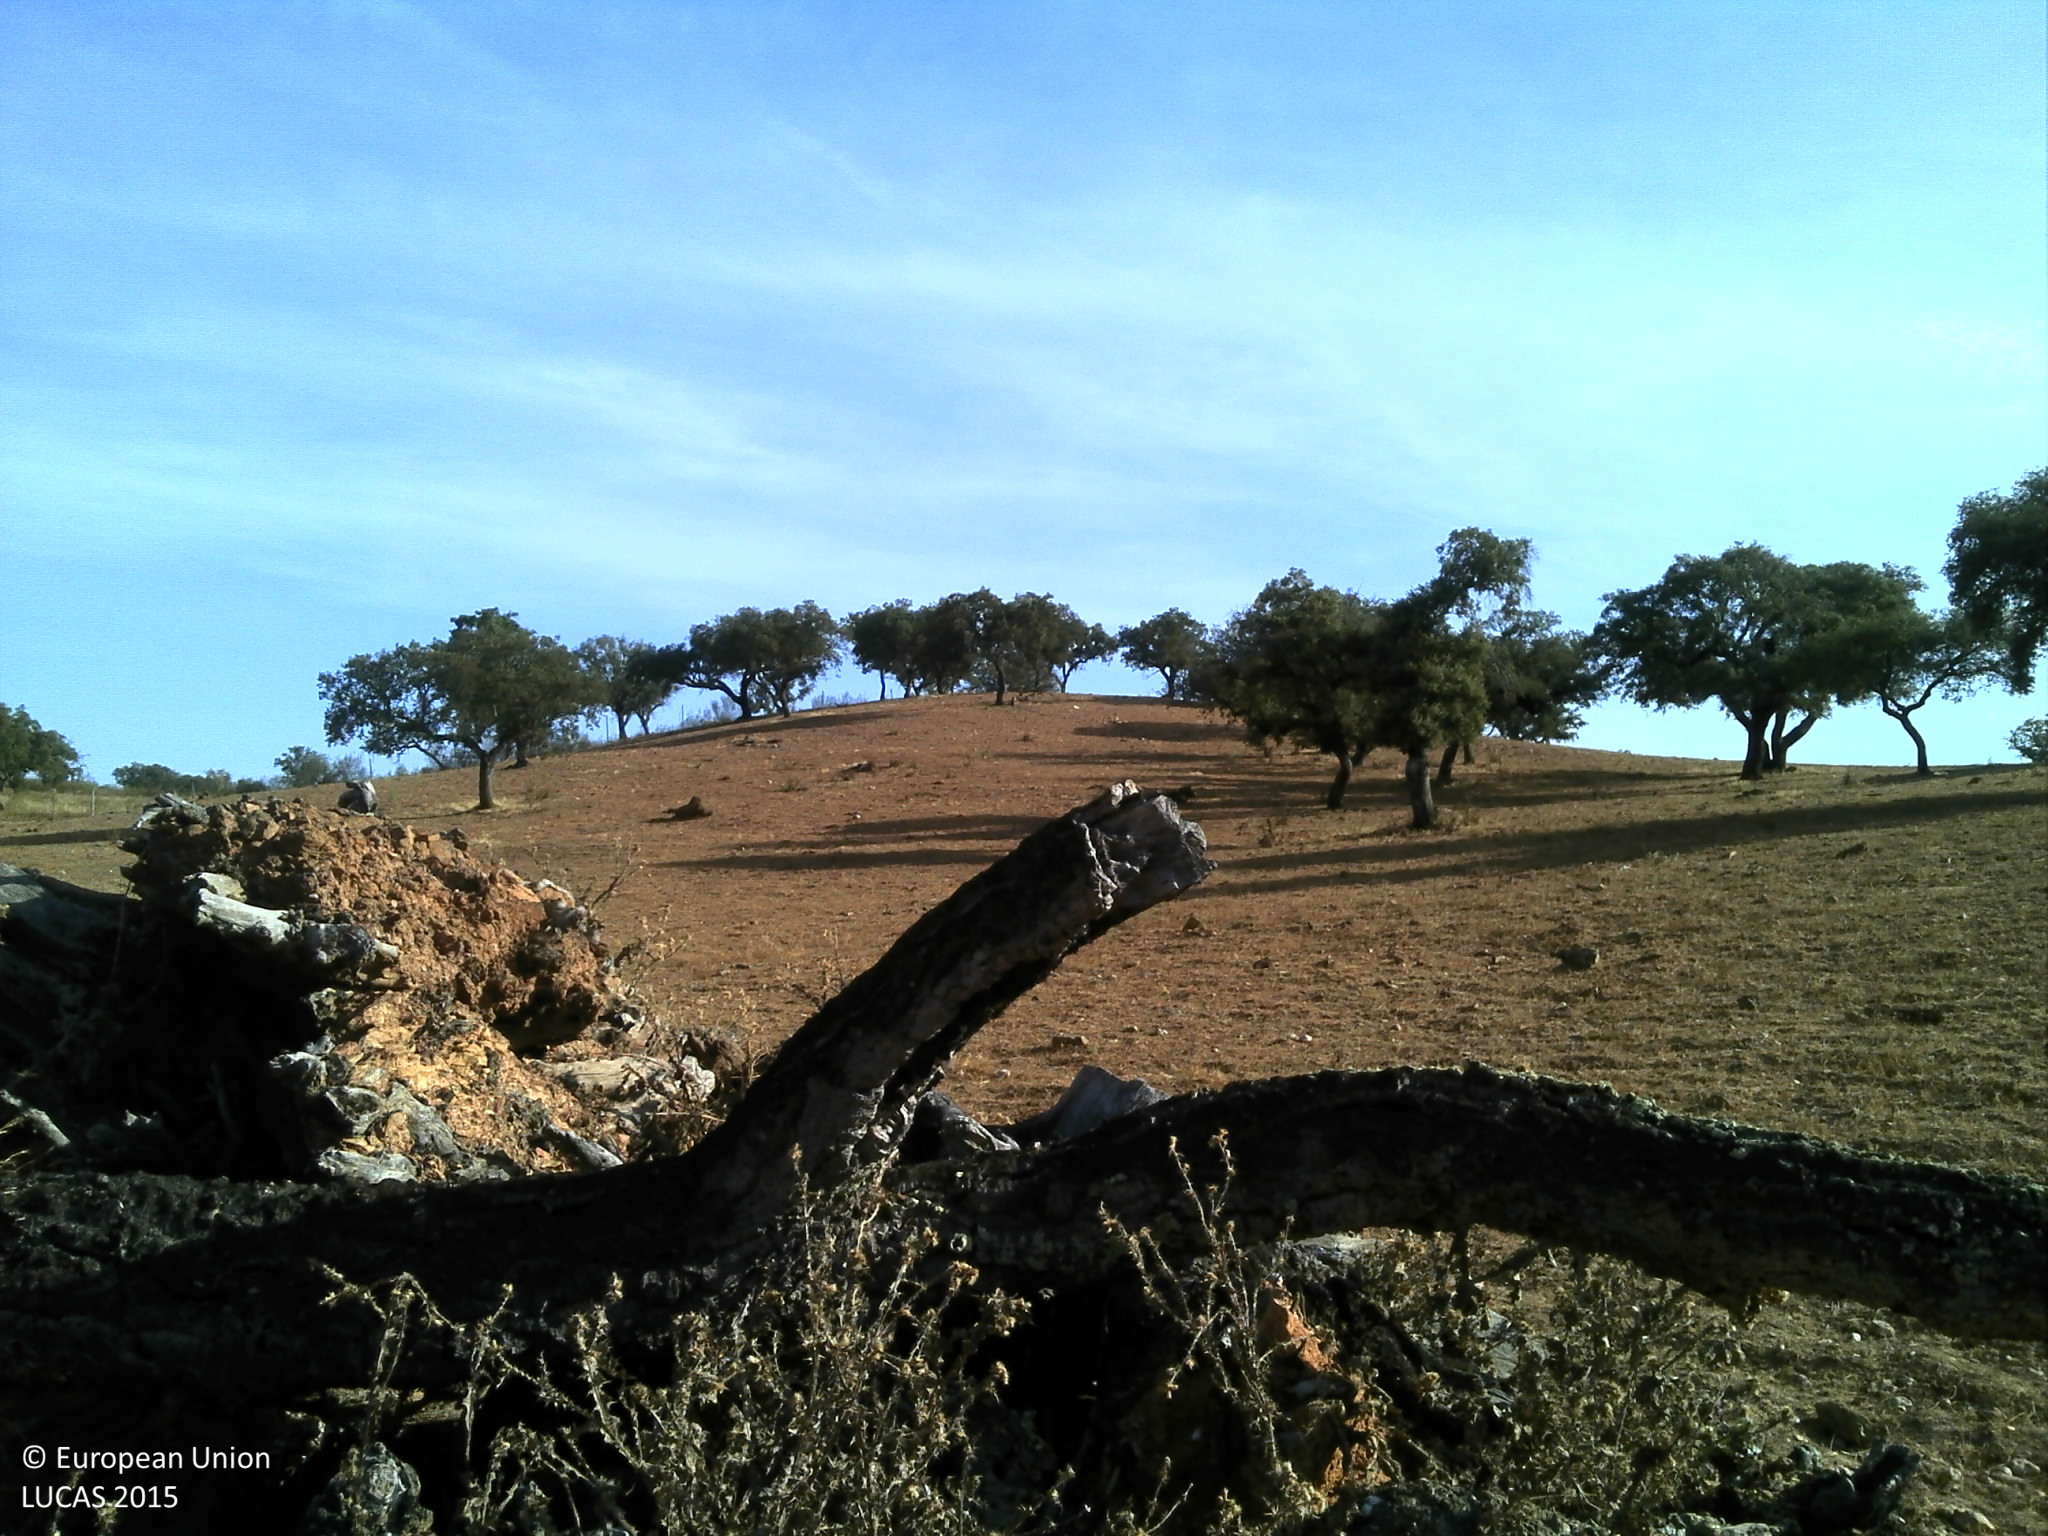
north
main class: Woodland
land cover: Broadleaved woodland
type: broadleaved evergreen forest
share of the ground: 10 - 25 %
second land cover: Grassland without tree/shrub cover
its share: 10 - 25 %
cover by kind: unconsolidated bare surface 80 %, broadleaved forest trees 10 %, herbaceous plants 10 %
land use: Forestry
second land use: Agriculture (excluding fallow land and kitchen gardens)
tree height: > 5 m
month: July
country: PT
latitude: 38.3236
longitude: -7.6321
